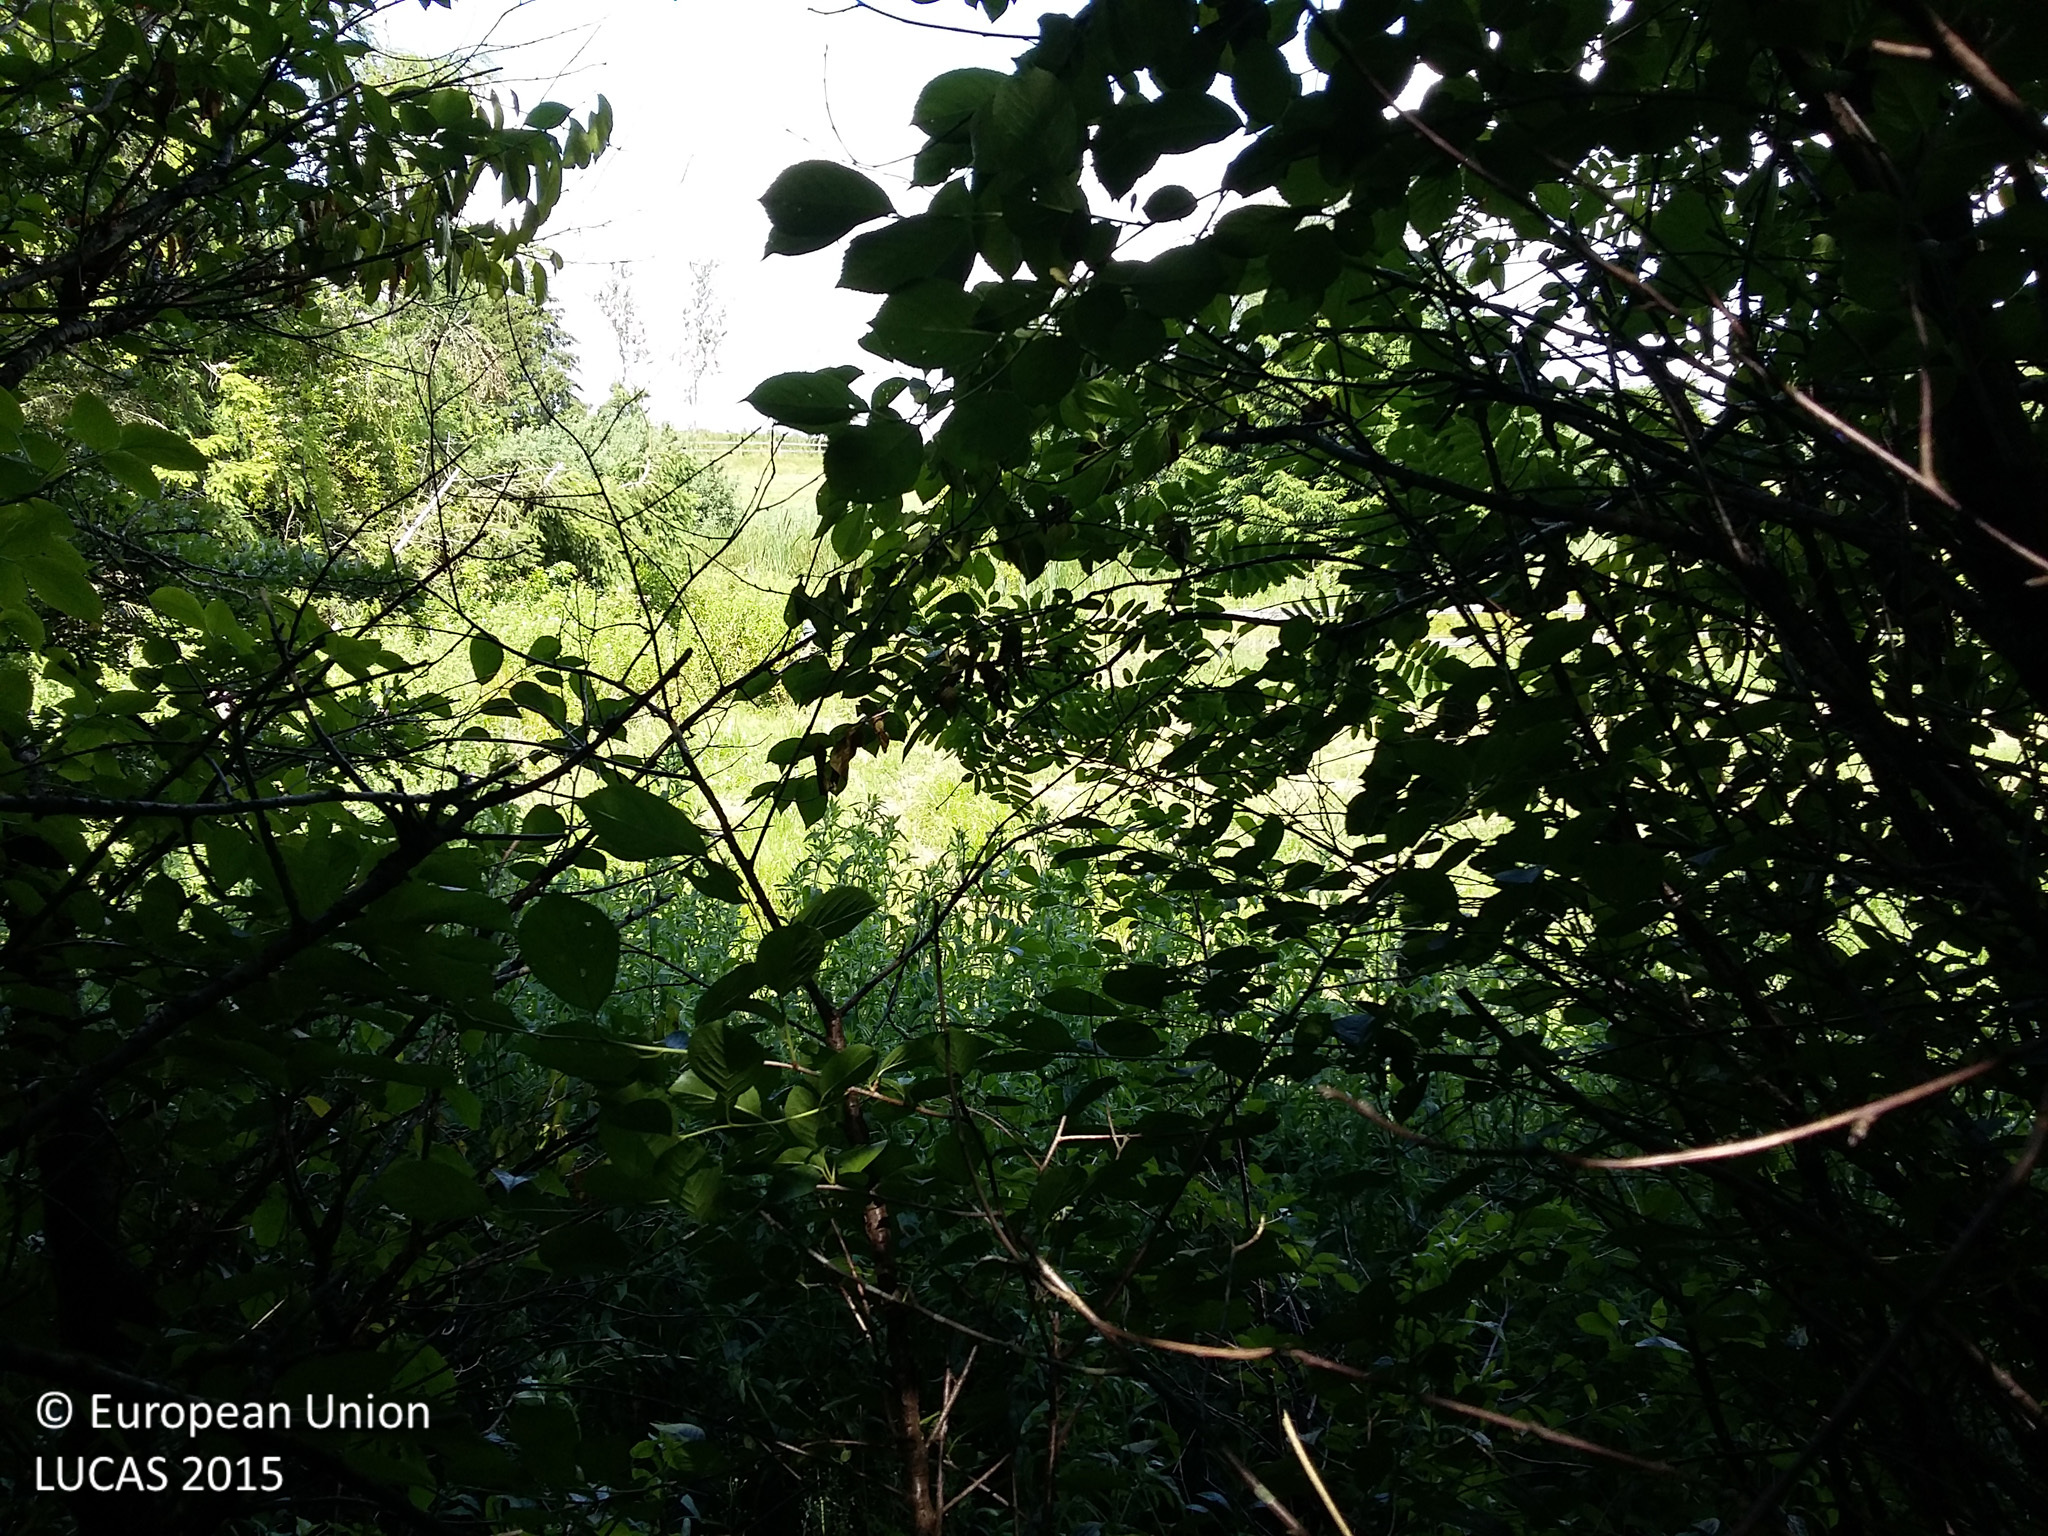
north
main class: Woodland
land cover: Broadleaved woodland
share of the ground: > 75 %
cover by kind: broadleaved forest trees 90 %, herbaceous plants 10 %
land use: Railway transport
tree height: > 5 m
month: July
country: DK
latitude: 55.5314
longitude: 11.5354
